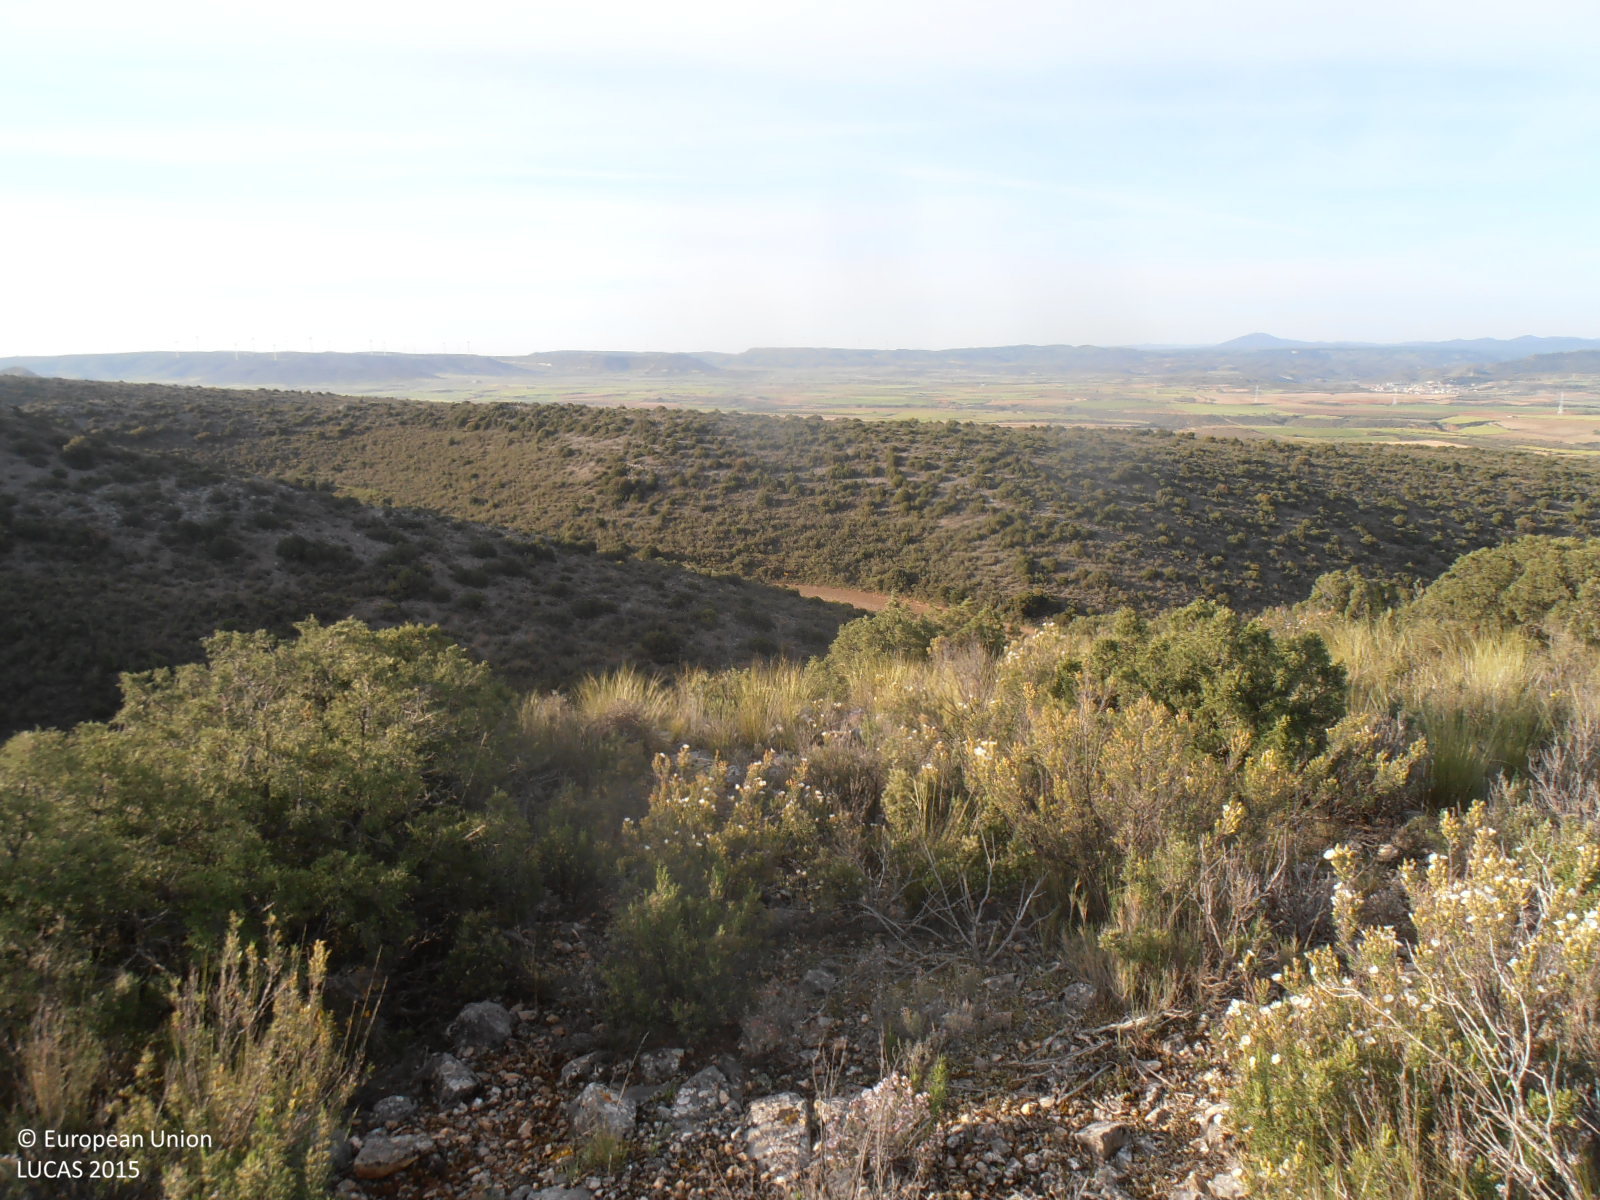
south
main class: Shrubland
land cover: Shrubland with sparse tree cover
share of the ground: > 75 %
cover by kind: shrubs 80 %, consolidated bare surface 10 %, coniferous forest trees 5 %, herbaceous plants 5 %
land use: Semi-natural and natural areas not in use
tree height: < 5 m
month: April
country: ES
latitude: 41.3959
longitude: -1.0120
